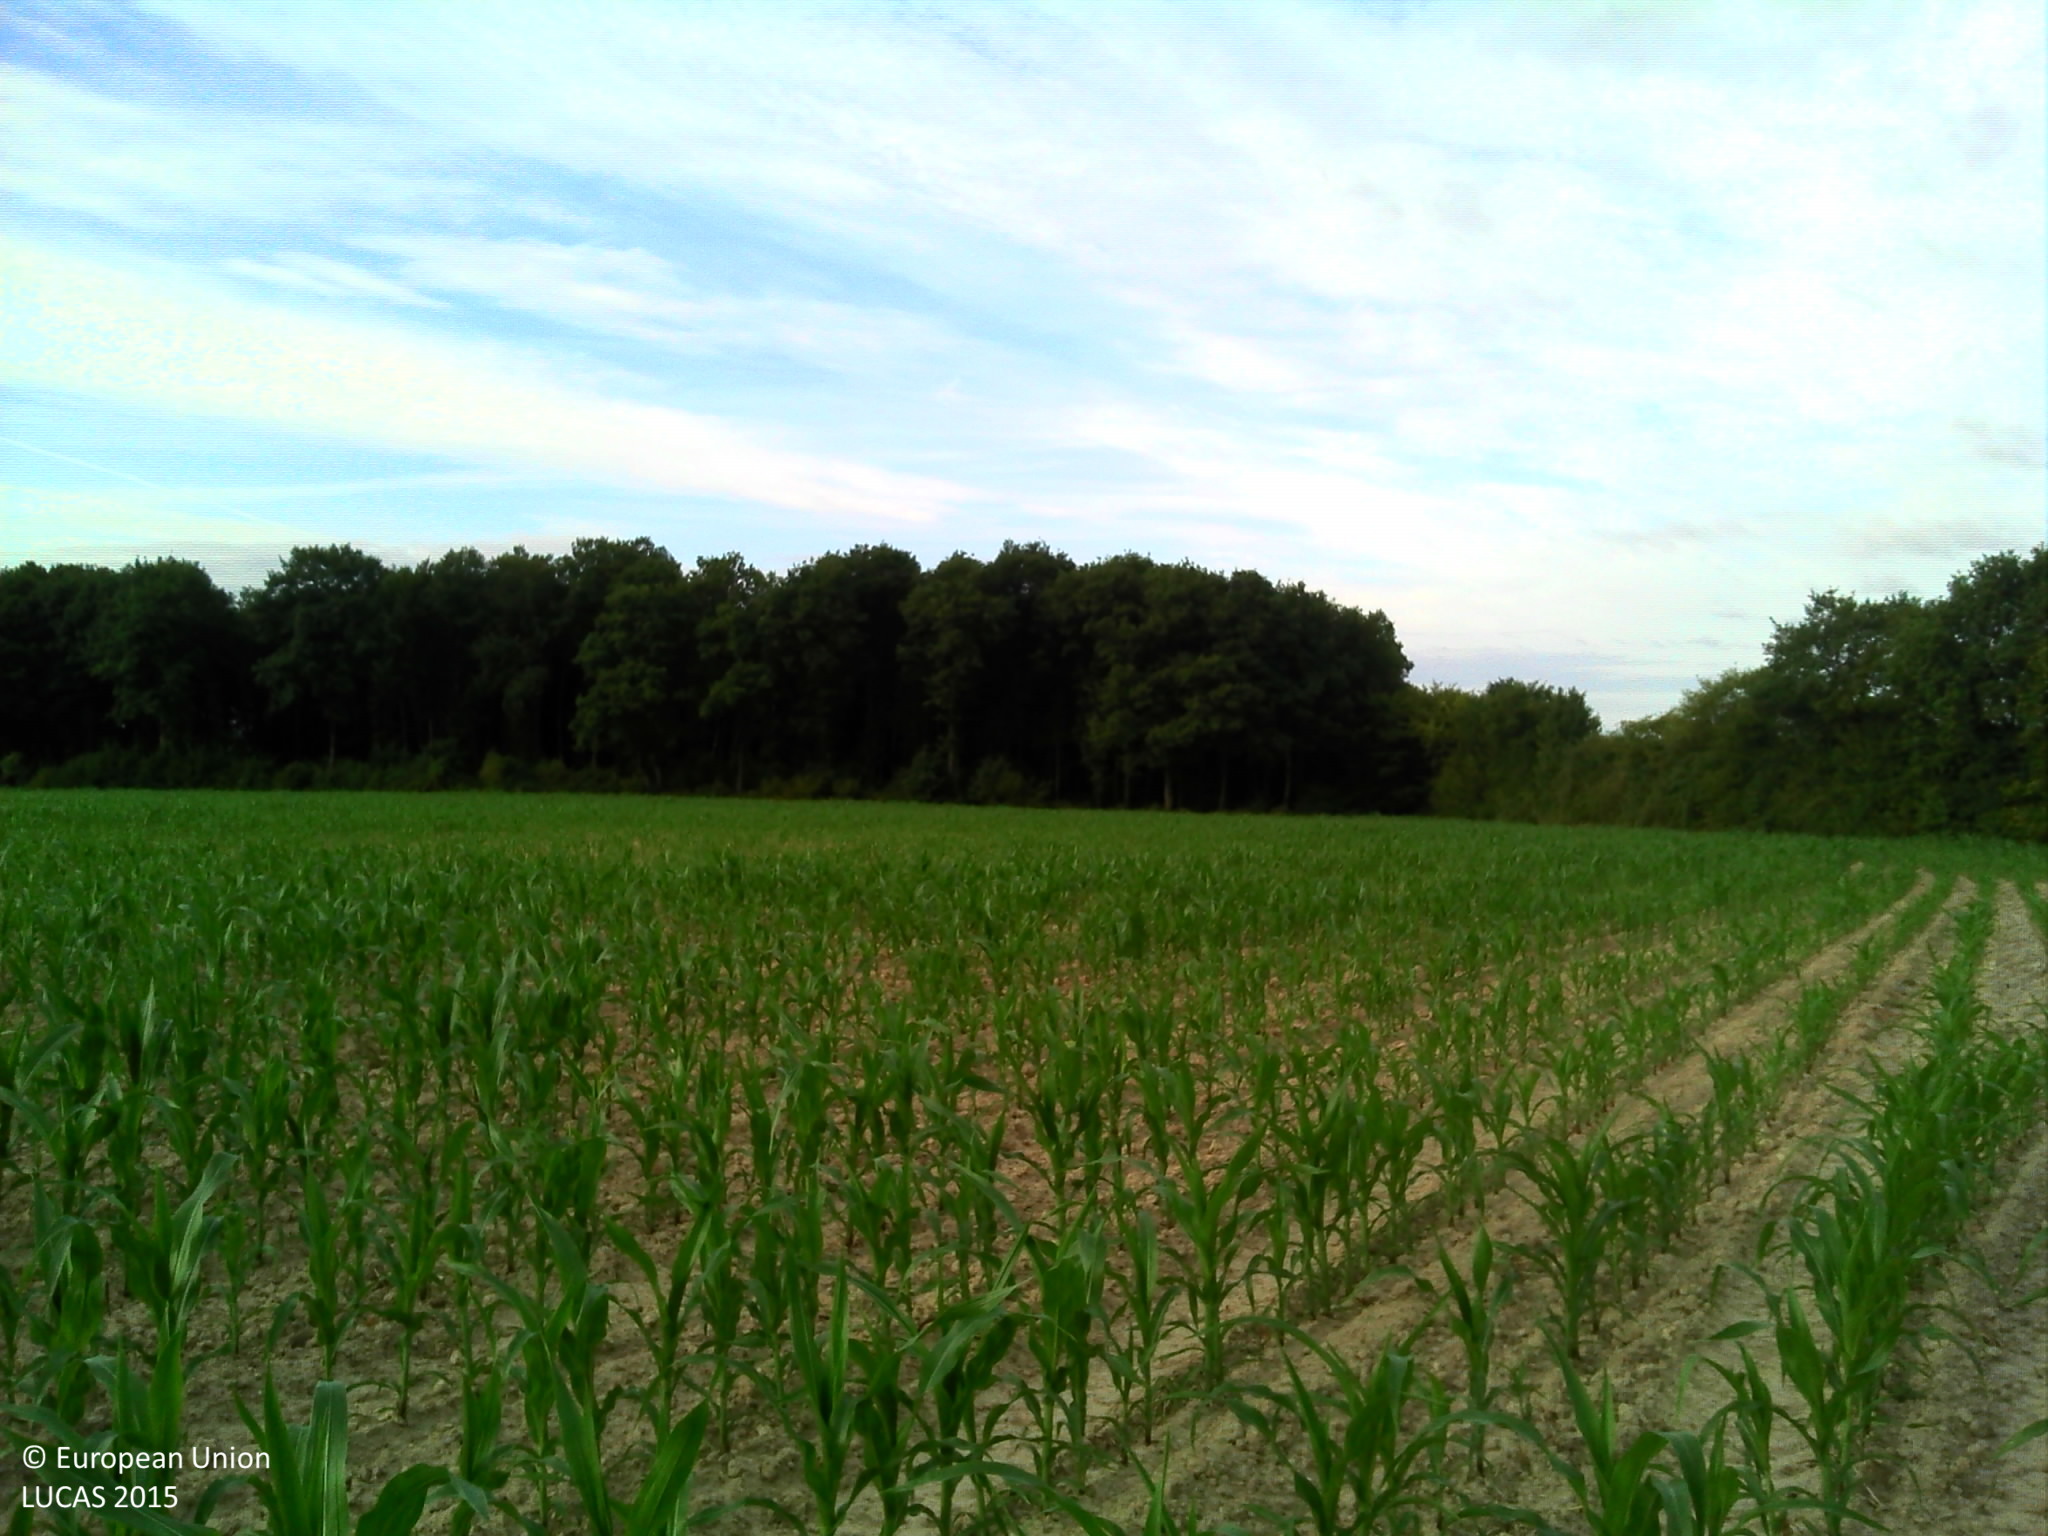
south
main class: Cropland
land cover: Maize
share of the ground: 25 - 50 %
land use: Agriculture (excluding fallow land and kitchen gardens)
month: July
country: FR
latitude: 47.7885
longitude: 0.4329
